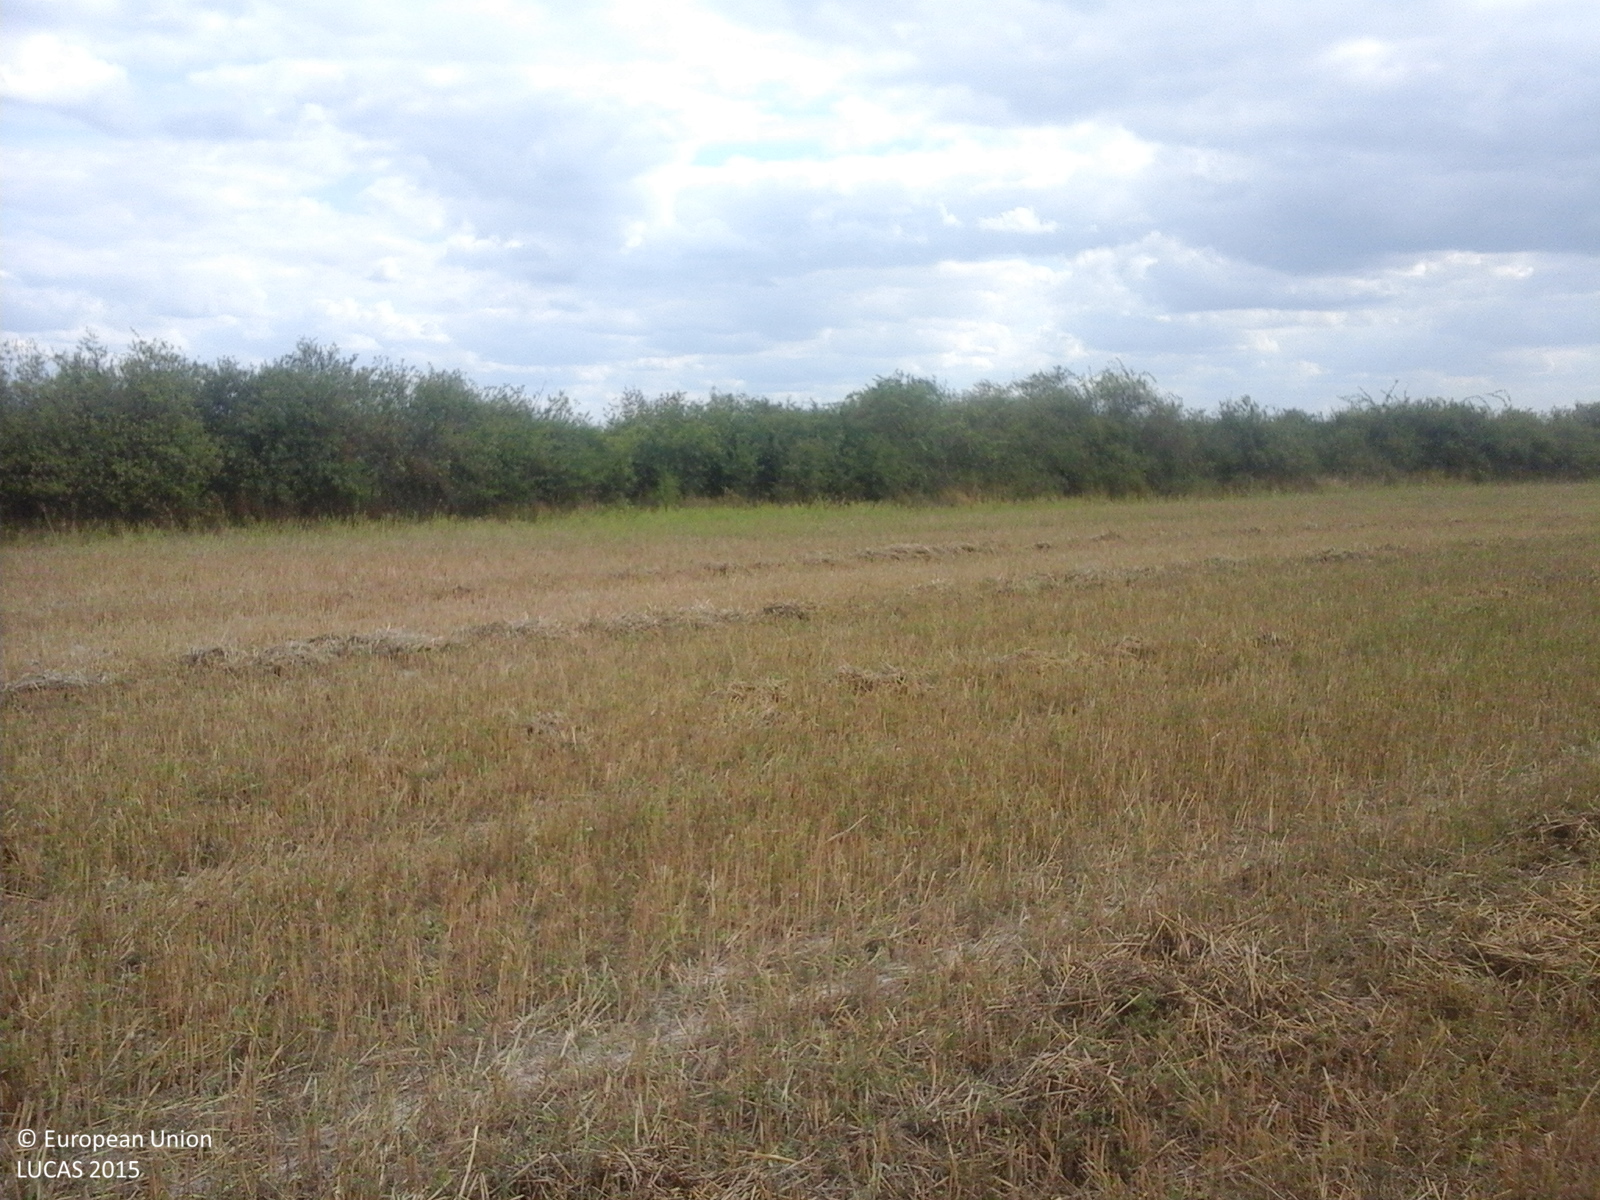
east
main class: Cropland
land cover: Common wheat
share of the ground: > 75 %
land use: Agriculture (excluding fallow land and kitchen gardens)
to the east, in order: Common wheat; Grass margins; Shrubland with sparse tree cover; Tracks; Shrubland with sparse tree cover; Ditches and canals; Shrubland with sparse tree cover; Sunflower
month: September
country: RO
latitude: 47.9061
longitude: 22.8409
